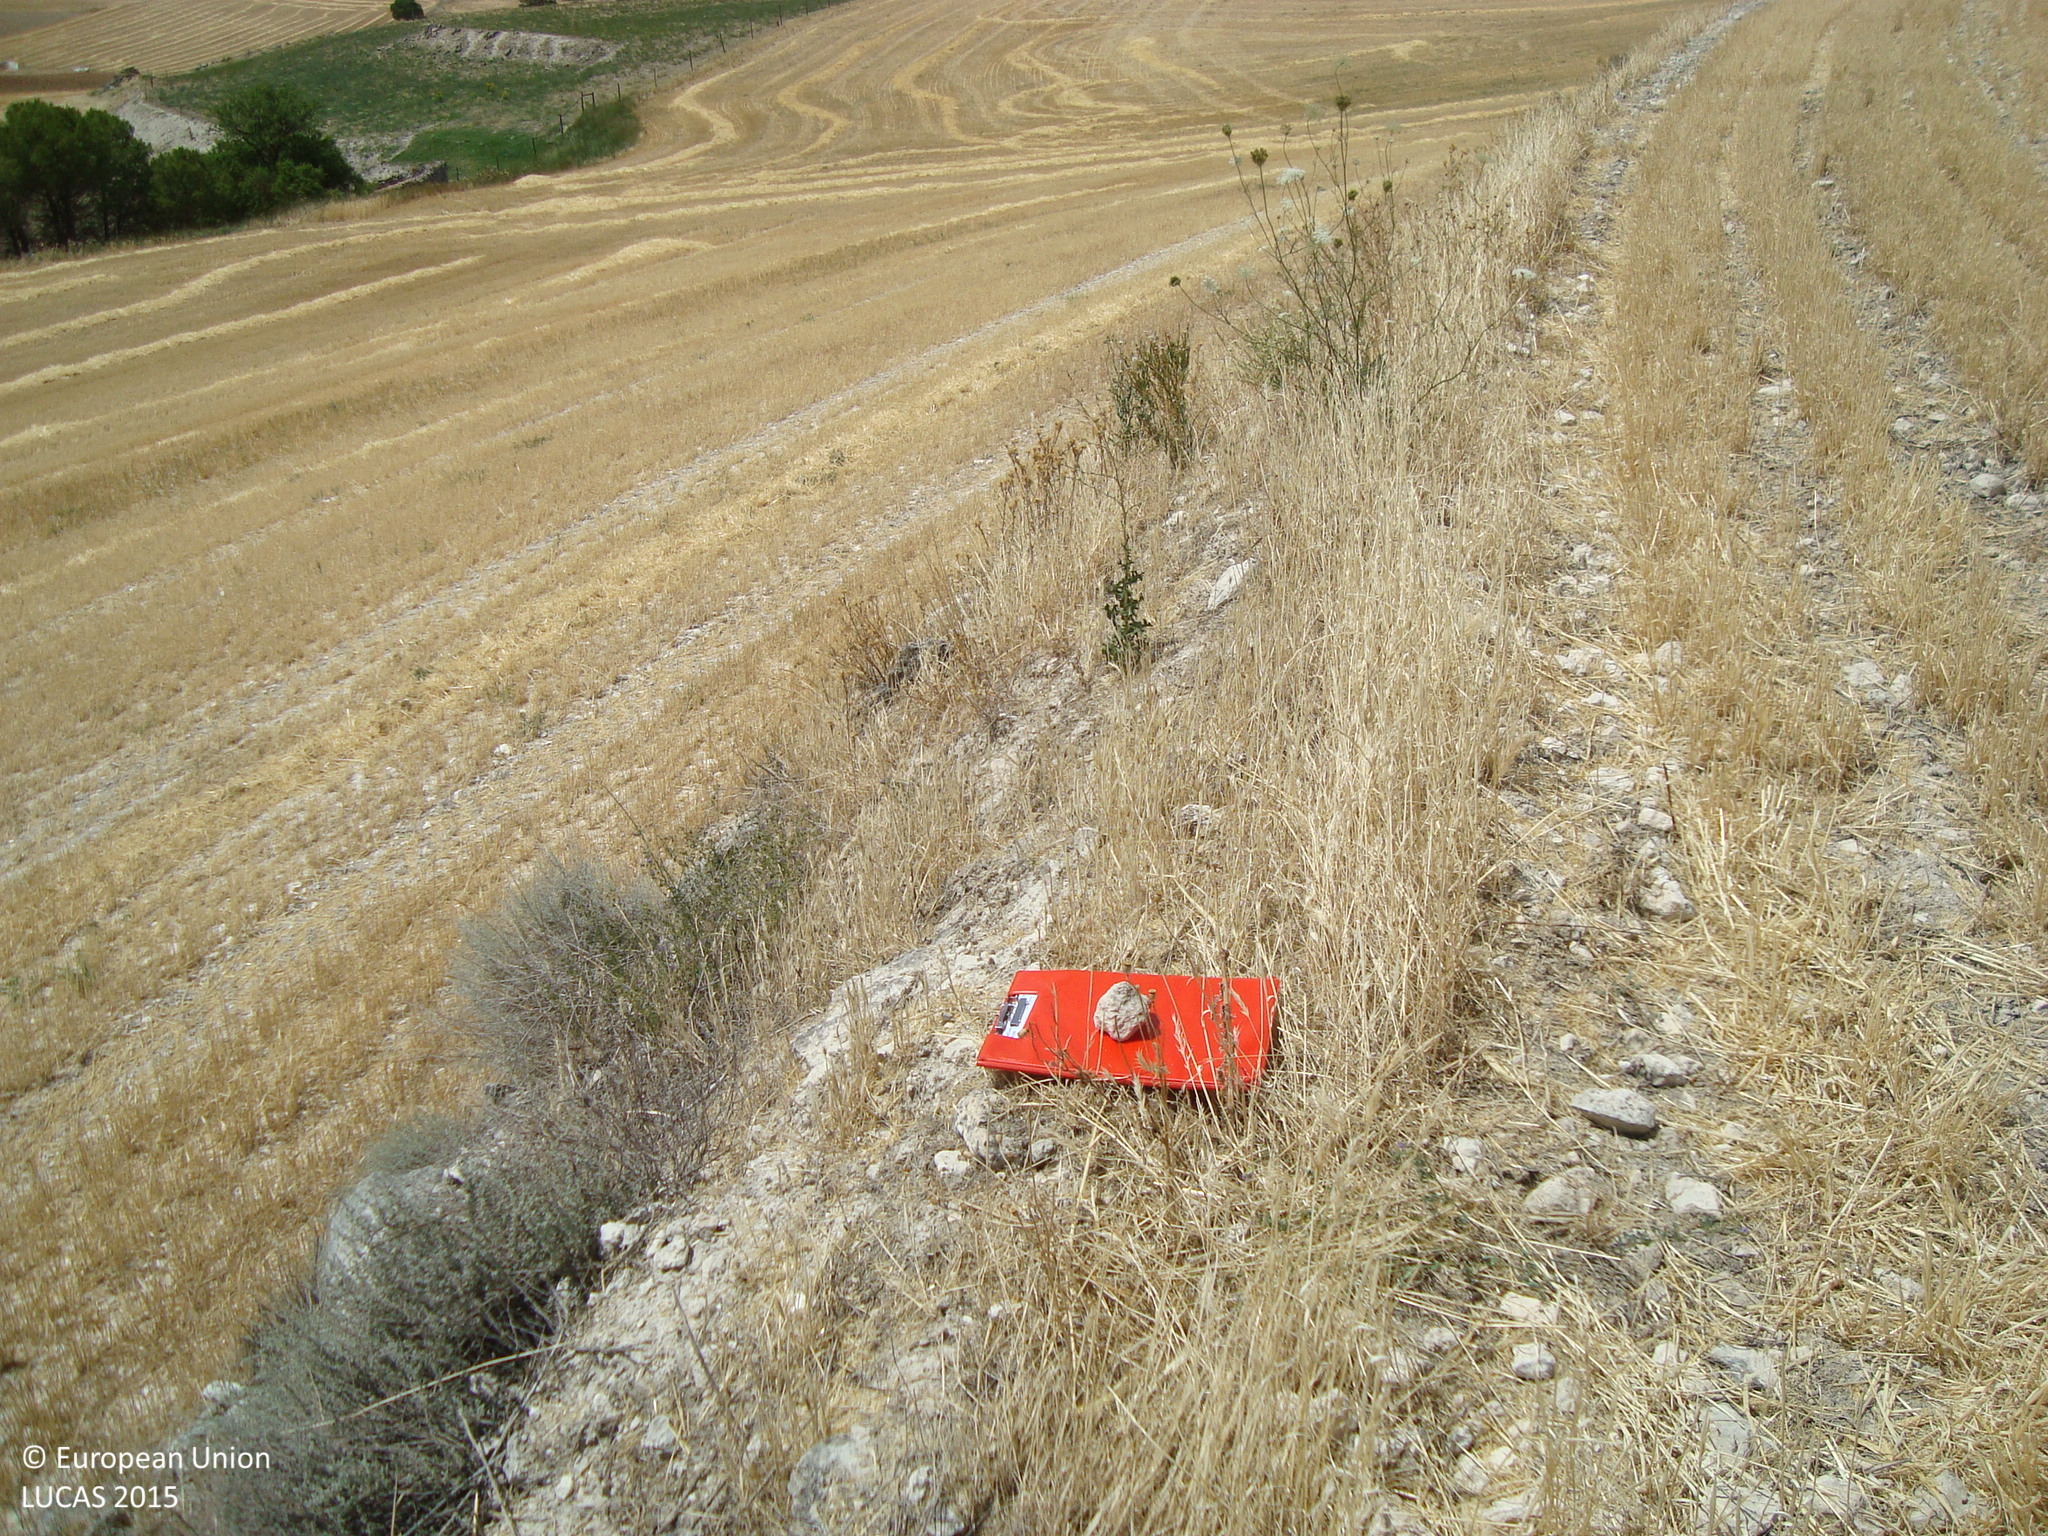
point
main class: Cropland
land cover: Barley
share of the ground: > 75 %
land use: Agriculture (excluding fallow land and kitchen gardens)
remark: Harvested field
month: July
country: ES
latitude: 41.9568
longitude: -4.2161
